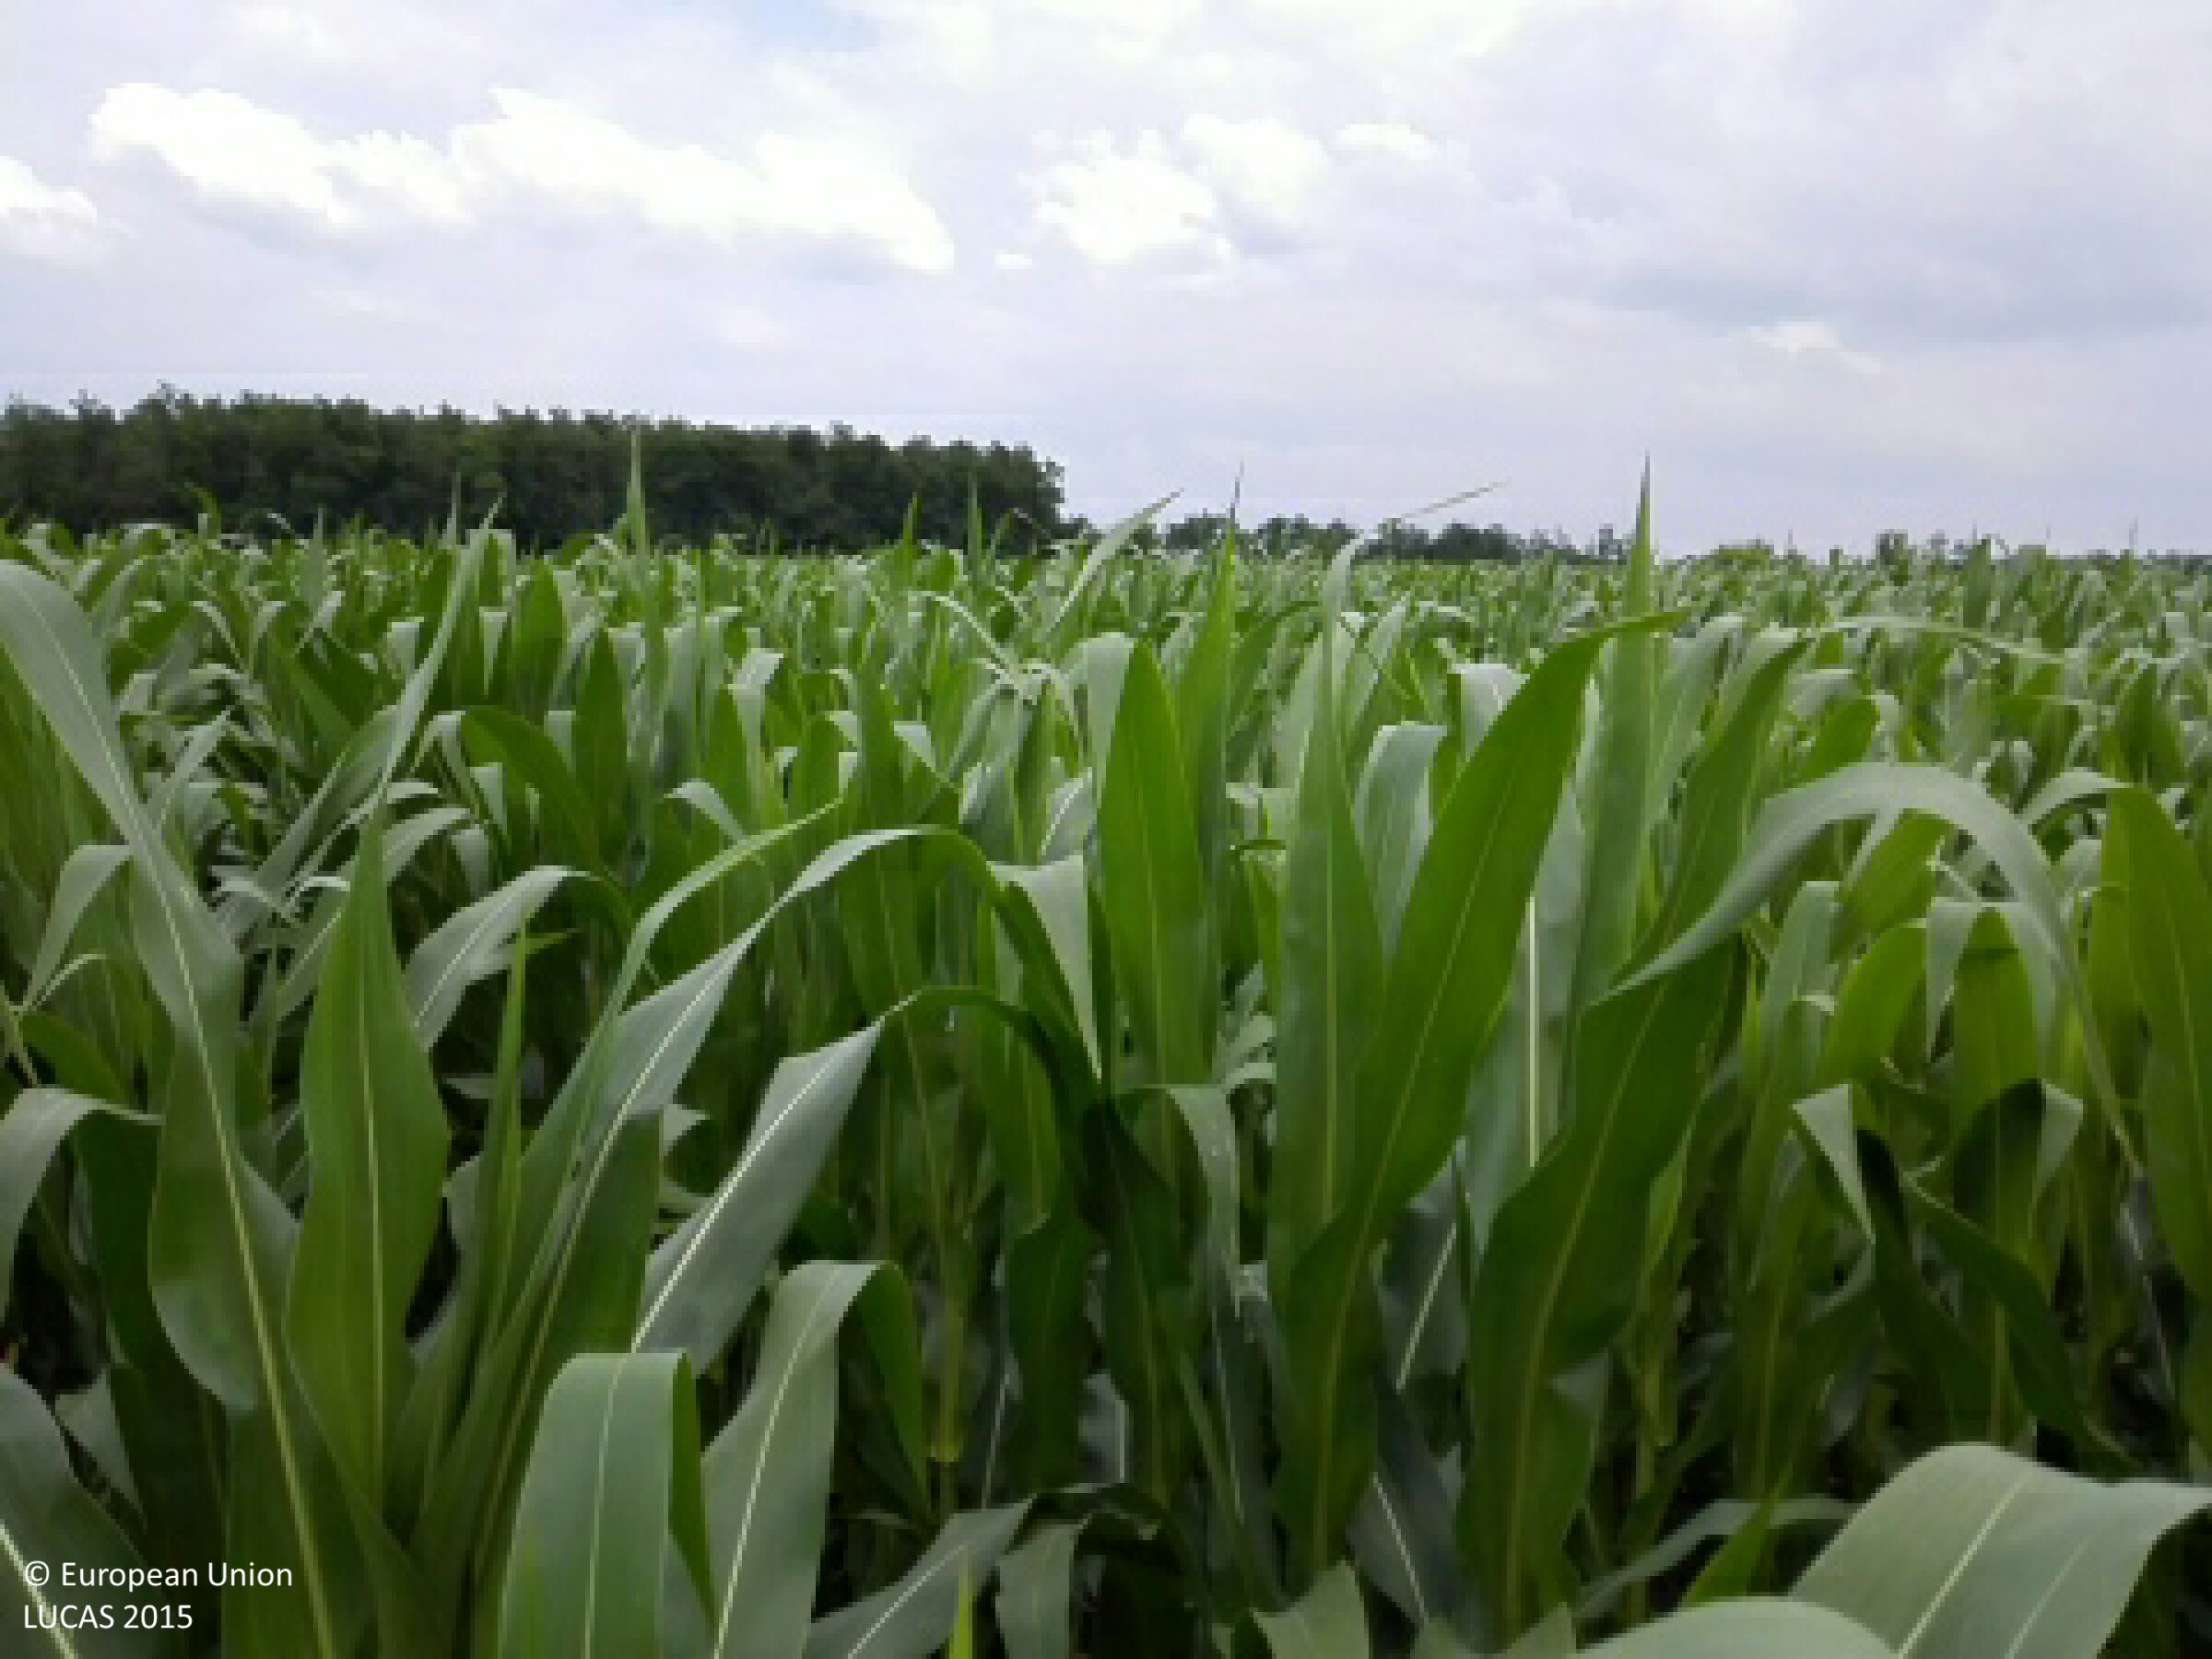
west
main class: Cropland
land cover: Maize
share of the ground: > 75 %
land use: Agriculture (excluding fallow land and kitchen gardens)
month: June
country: HU
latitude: 47.7148
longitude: 21.6289
